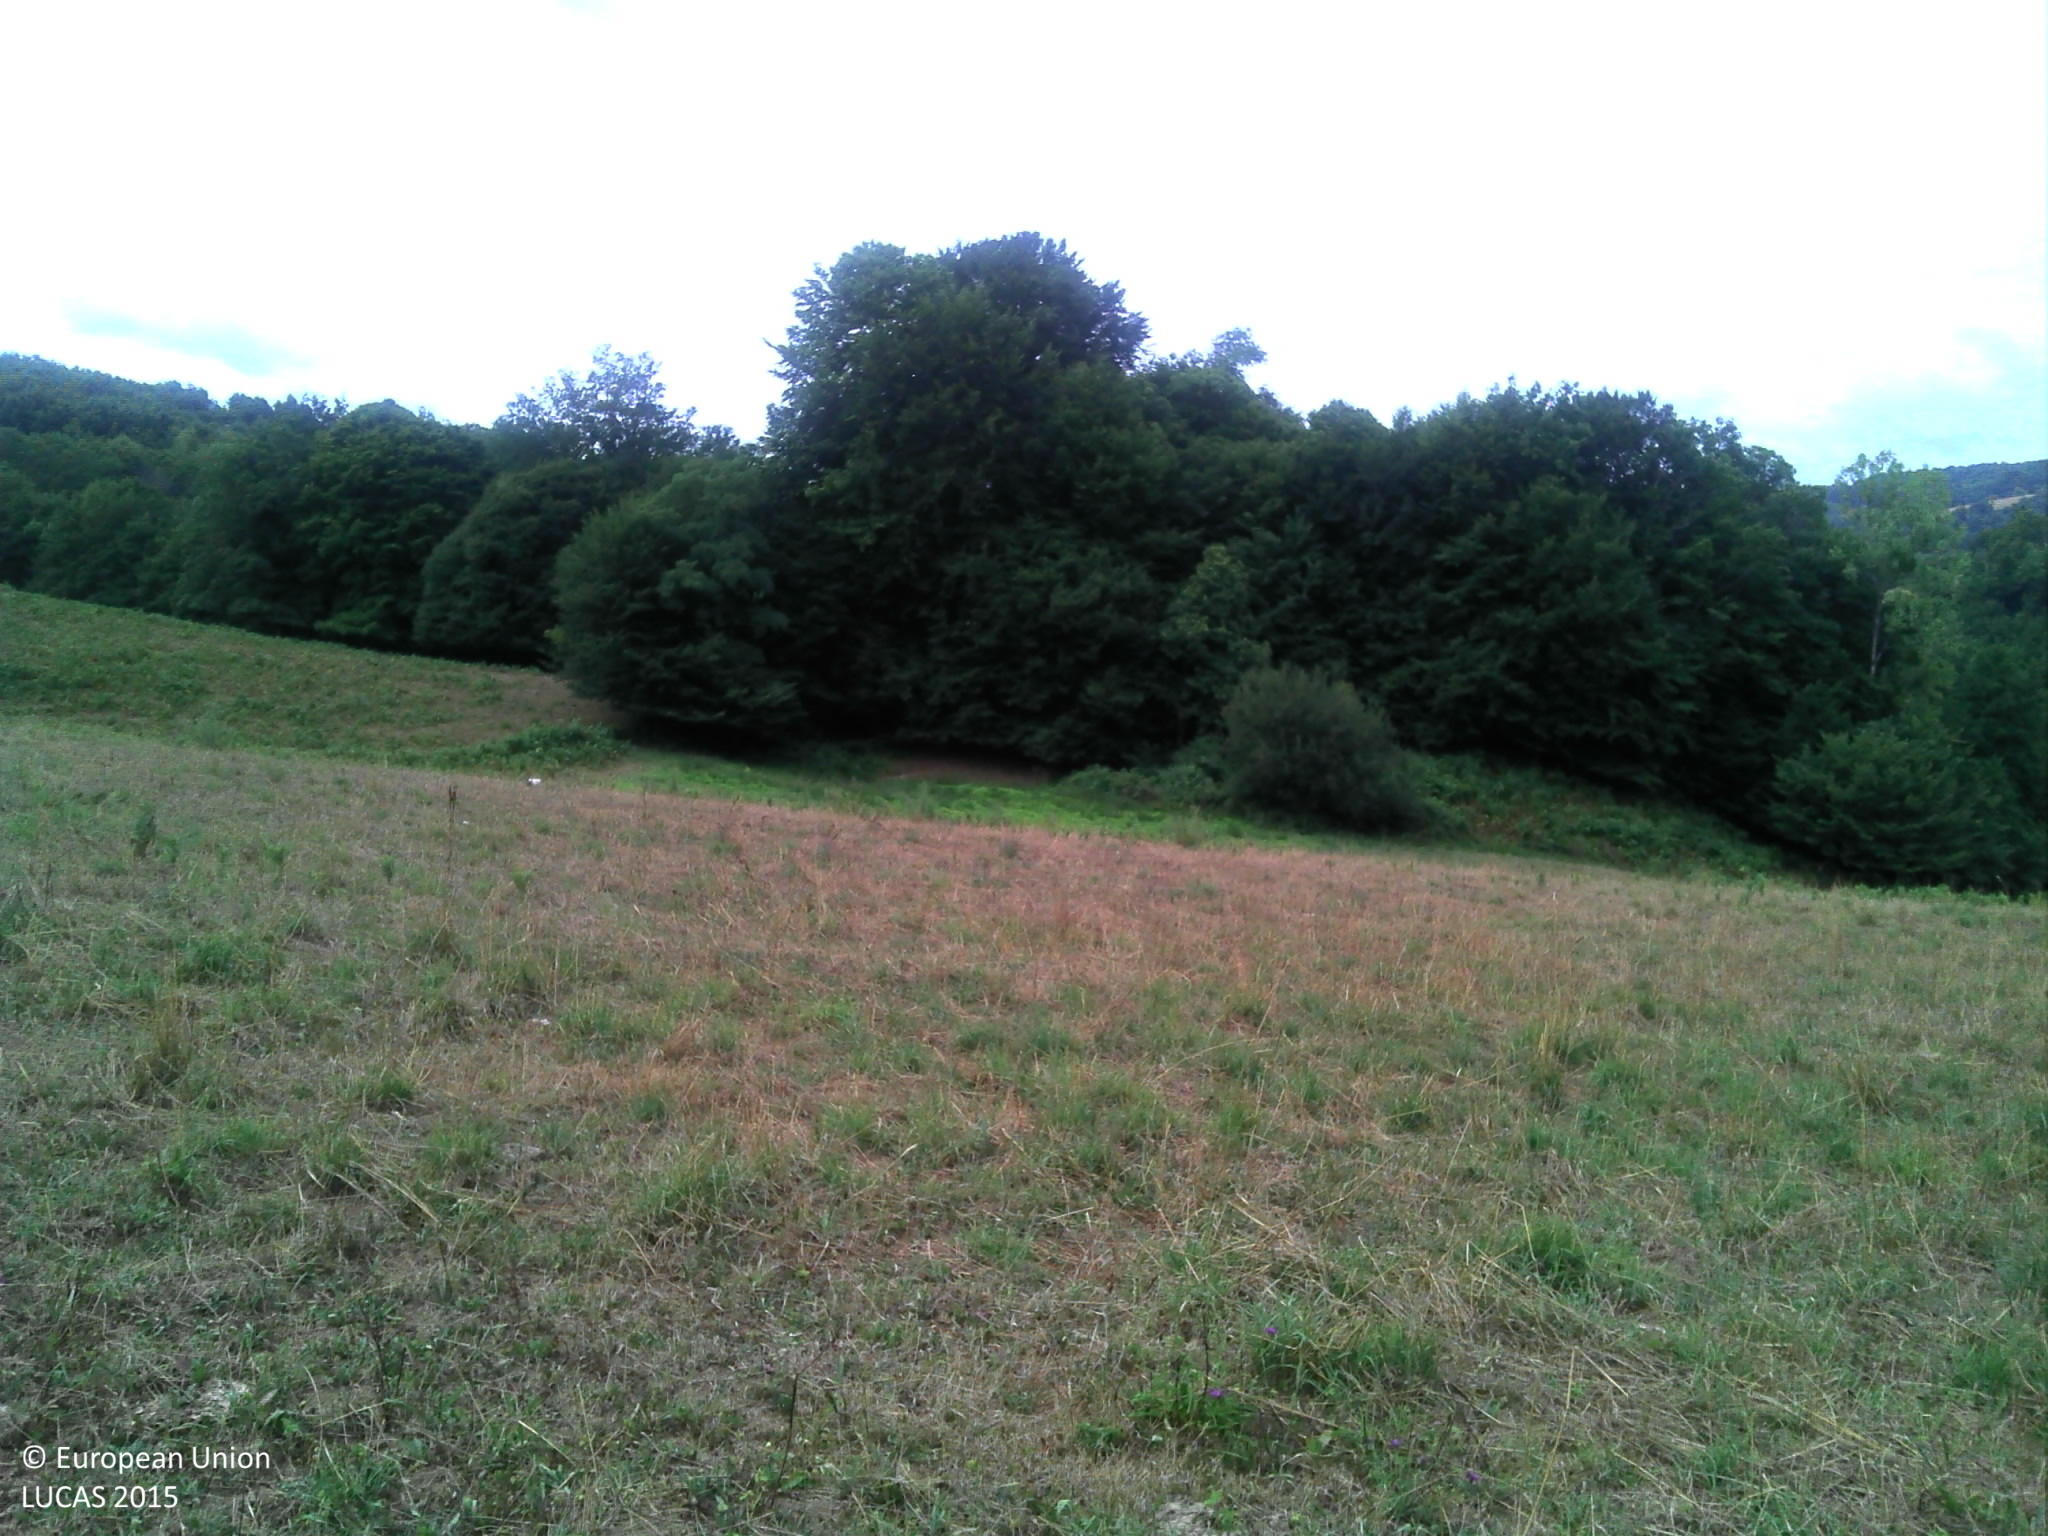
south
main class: Grassland
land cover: Grassland without tree/shrub cover
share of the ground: > 75 %
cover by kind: herbaceous plants 95 %, shrubs 5 %
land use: Agriculture (excluding fallow land and kitchen gardens)
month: July
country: FR
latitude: 45.3608
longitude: 1.5047
